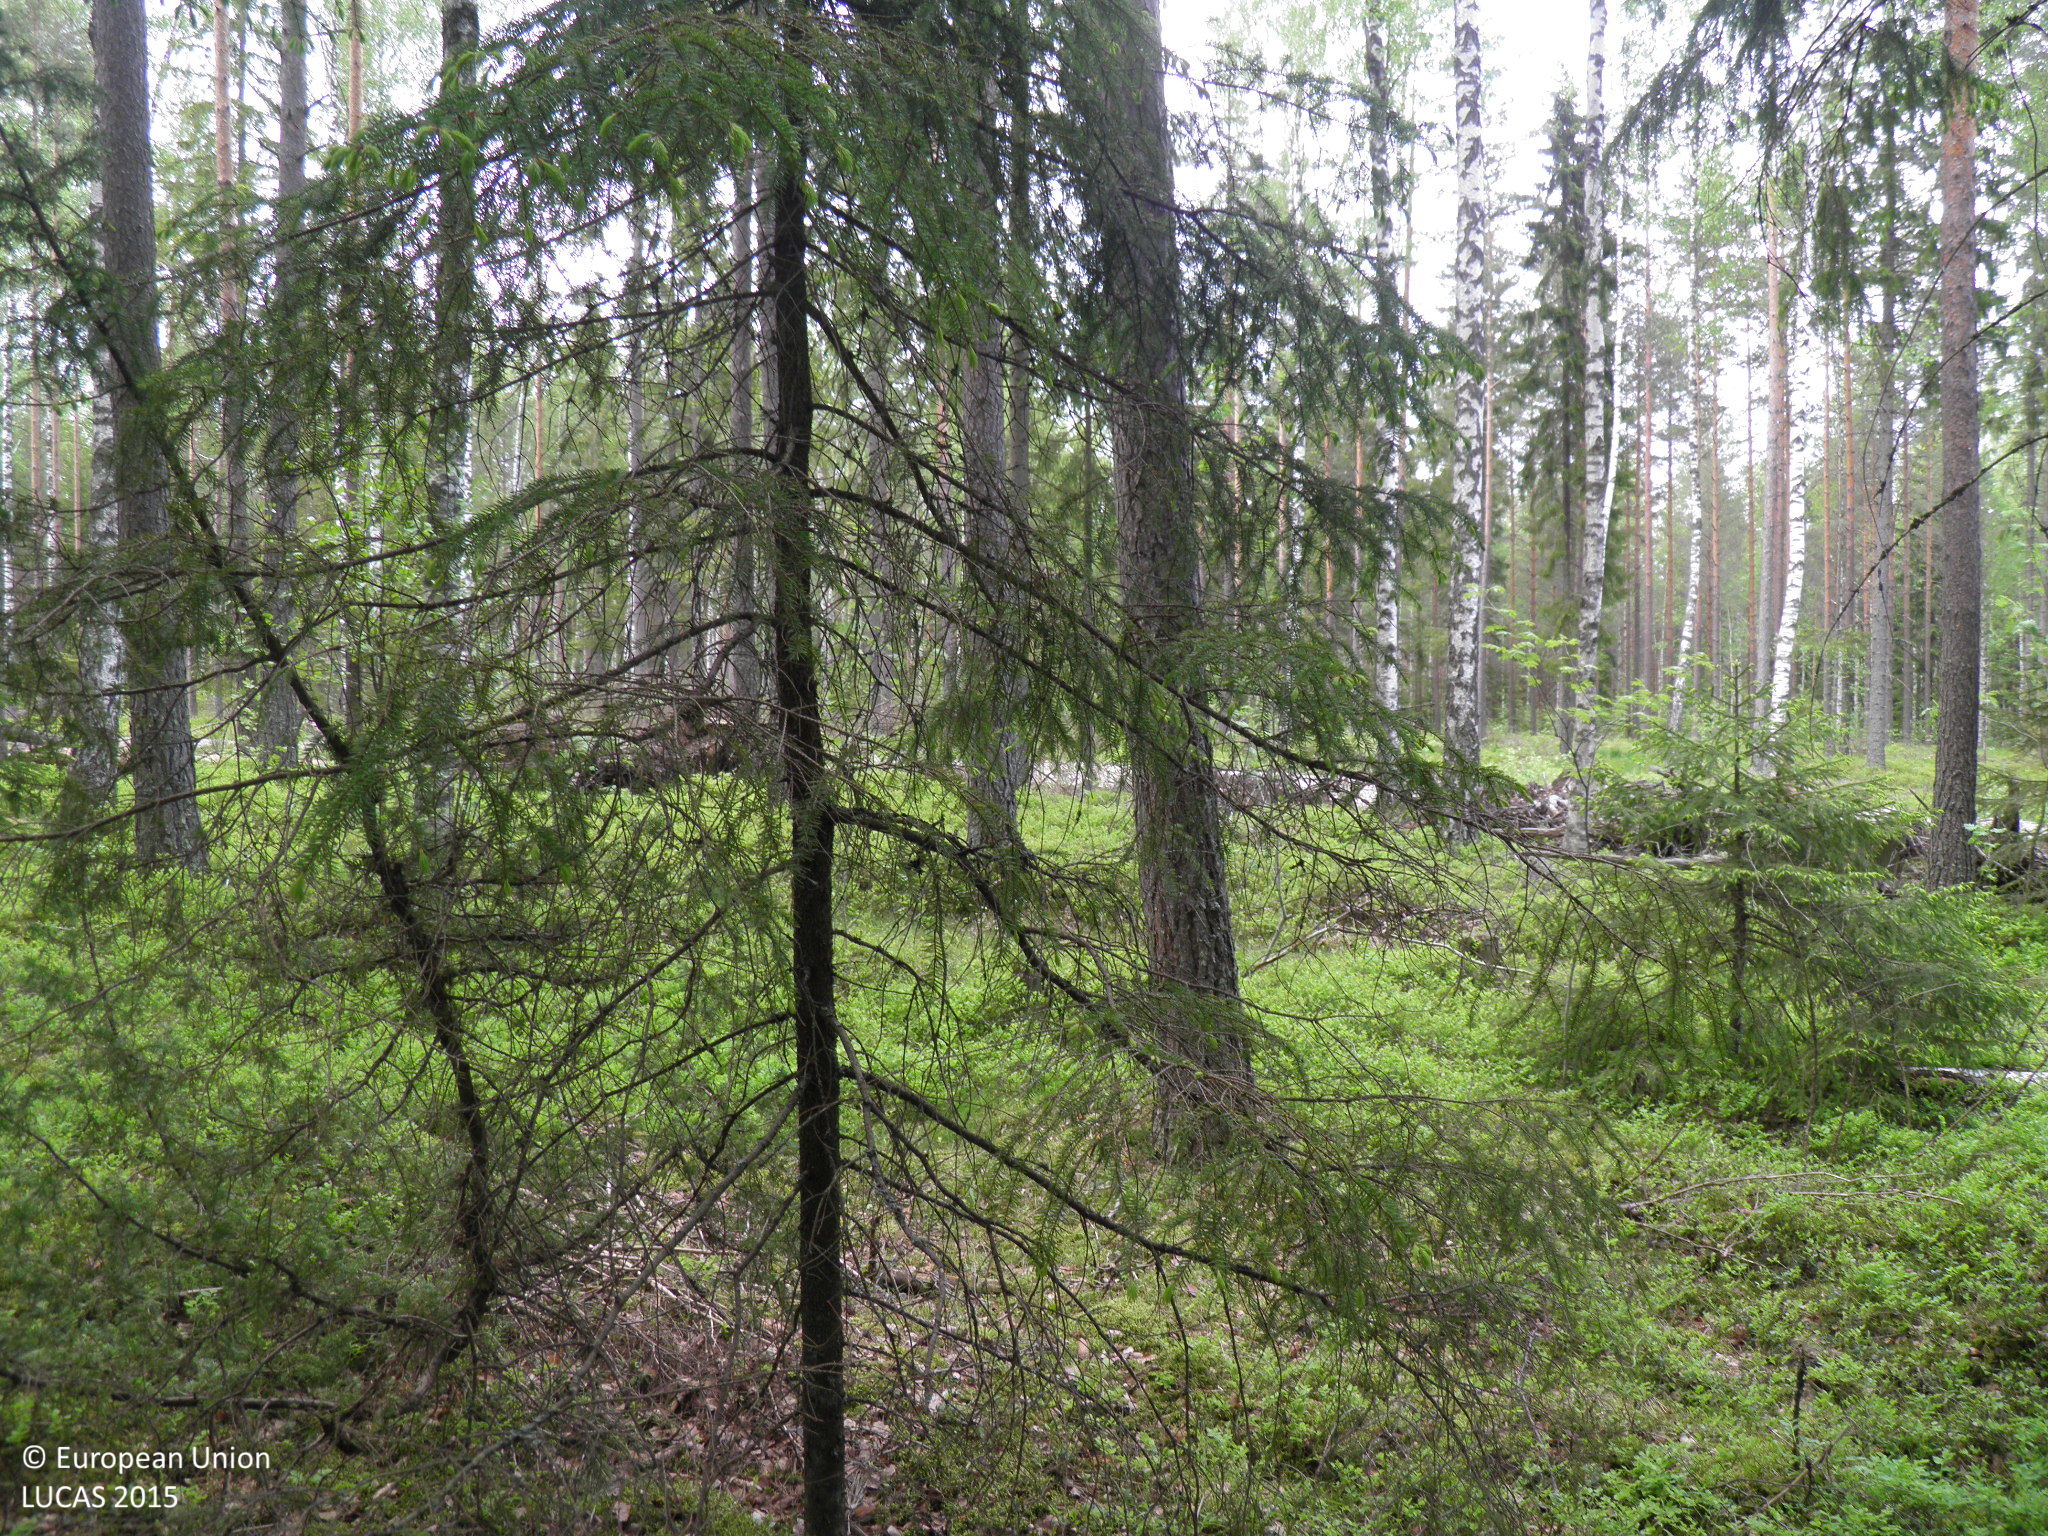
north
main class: Woodland
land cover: Pine dominated coniferous woodland
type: boreal forest
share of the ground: > 75 %
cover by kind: coniferous forest trees 70 %, broadleaved forest trees 20 %, shrubs 5 %, lichens and mosses 5 %
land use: Forestry
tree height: > 5 m
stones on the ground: < 10 %
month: June
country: FI
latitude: 60.5738
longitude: 22.6812
